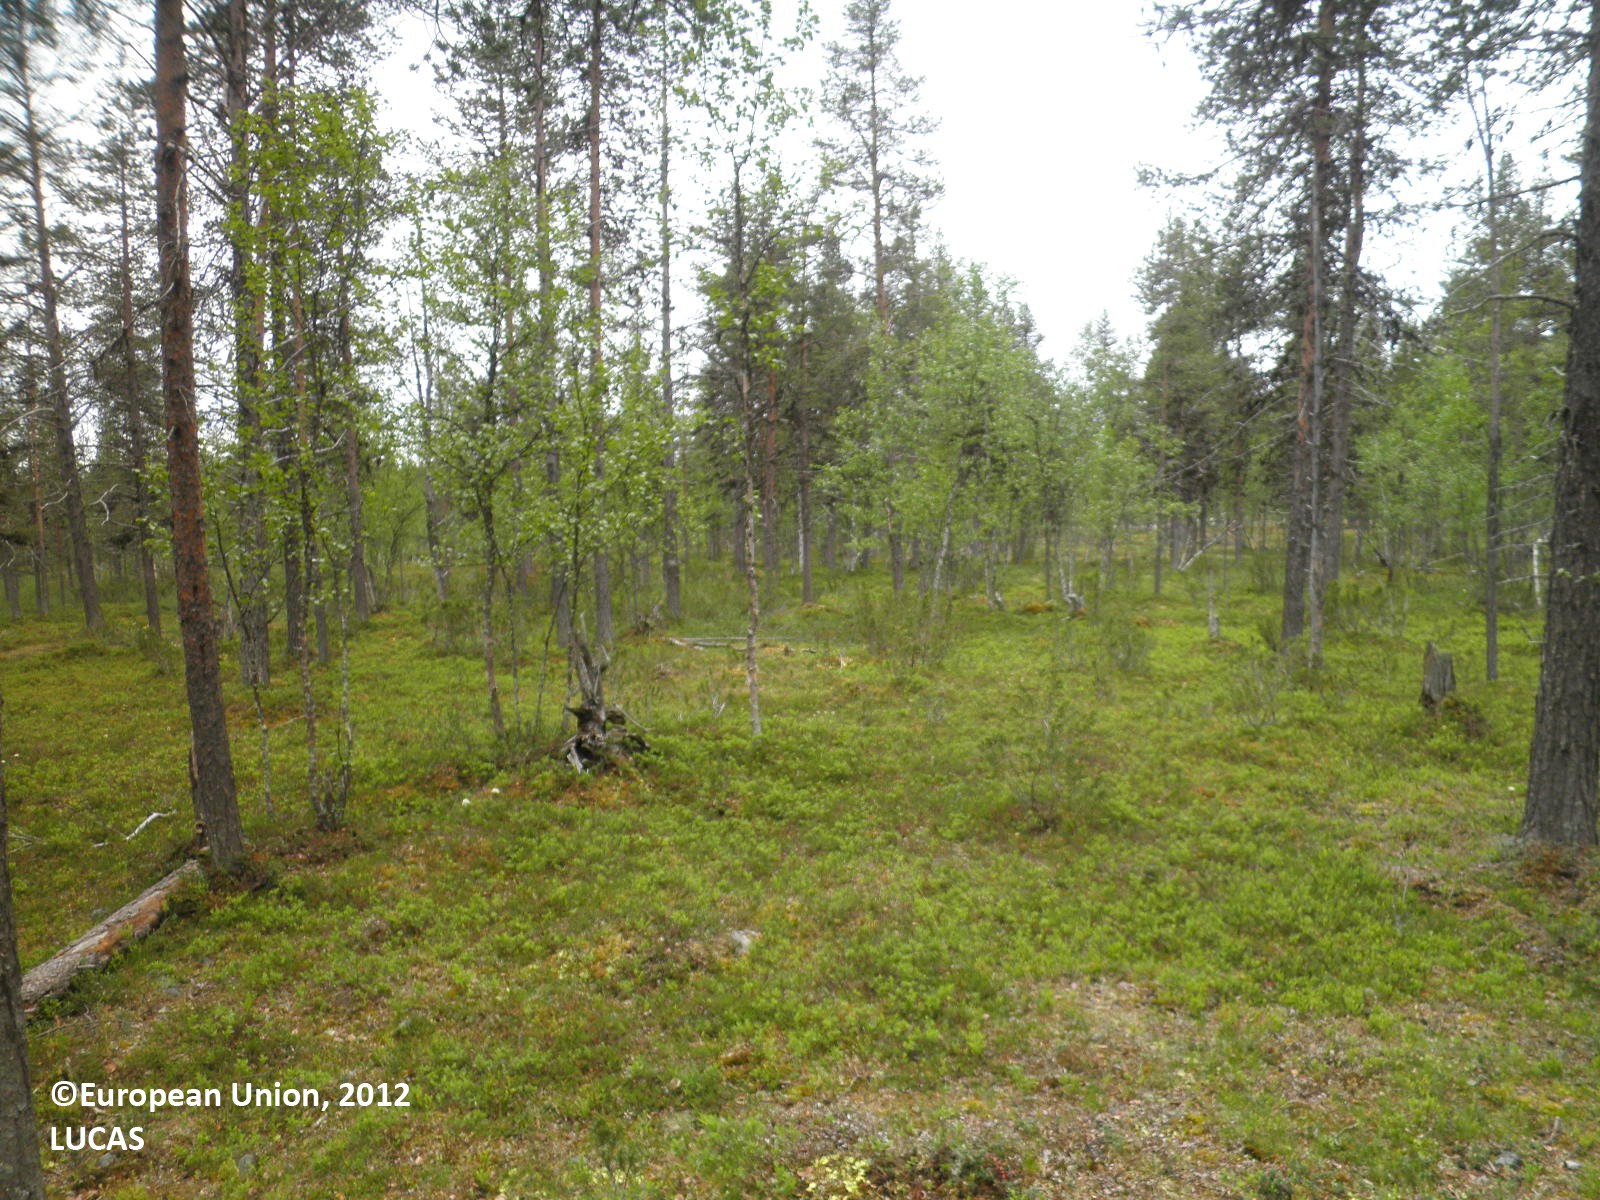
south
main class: Woodland
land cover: Pine dominated coniferous woodland
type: boreal forest
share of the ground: 25 - 50 %
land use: Forestry
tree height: > 5 m
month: July
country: FI
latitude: 68.4322
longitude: 25.9115
